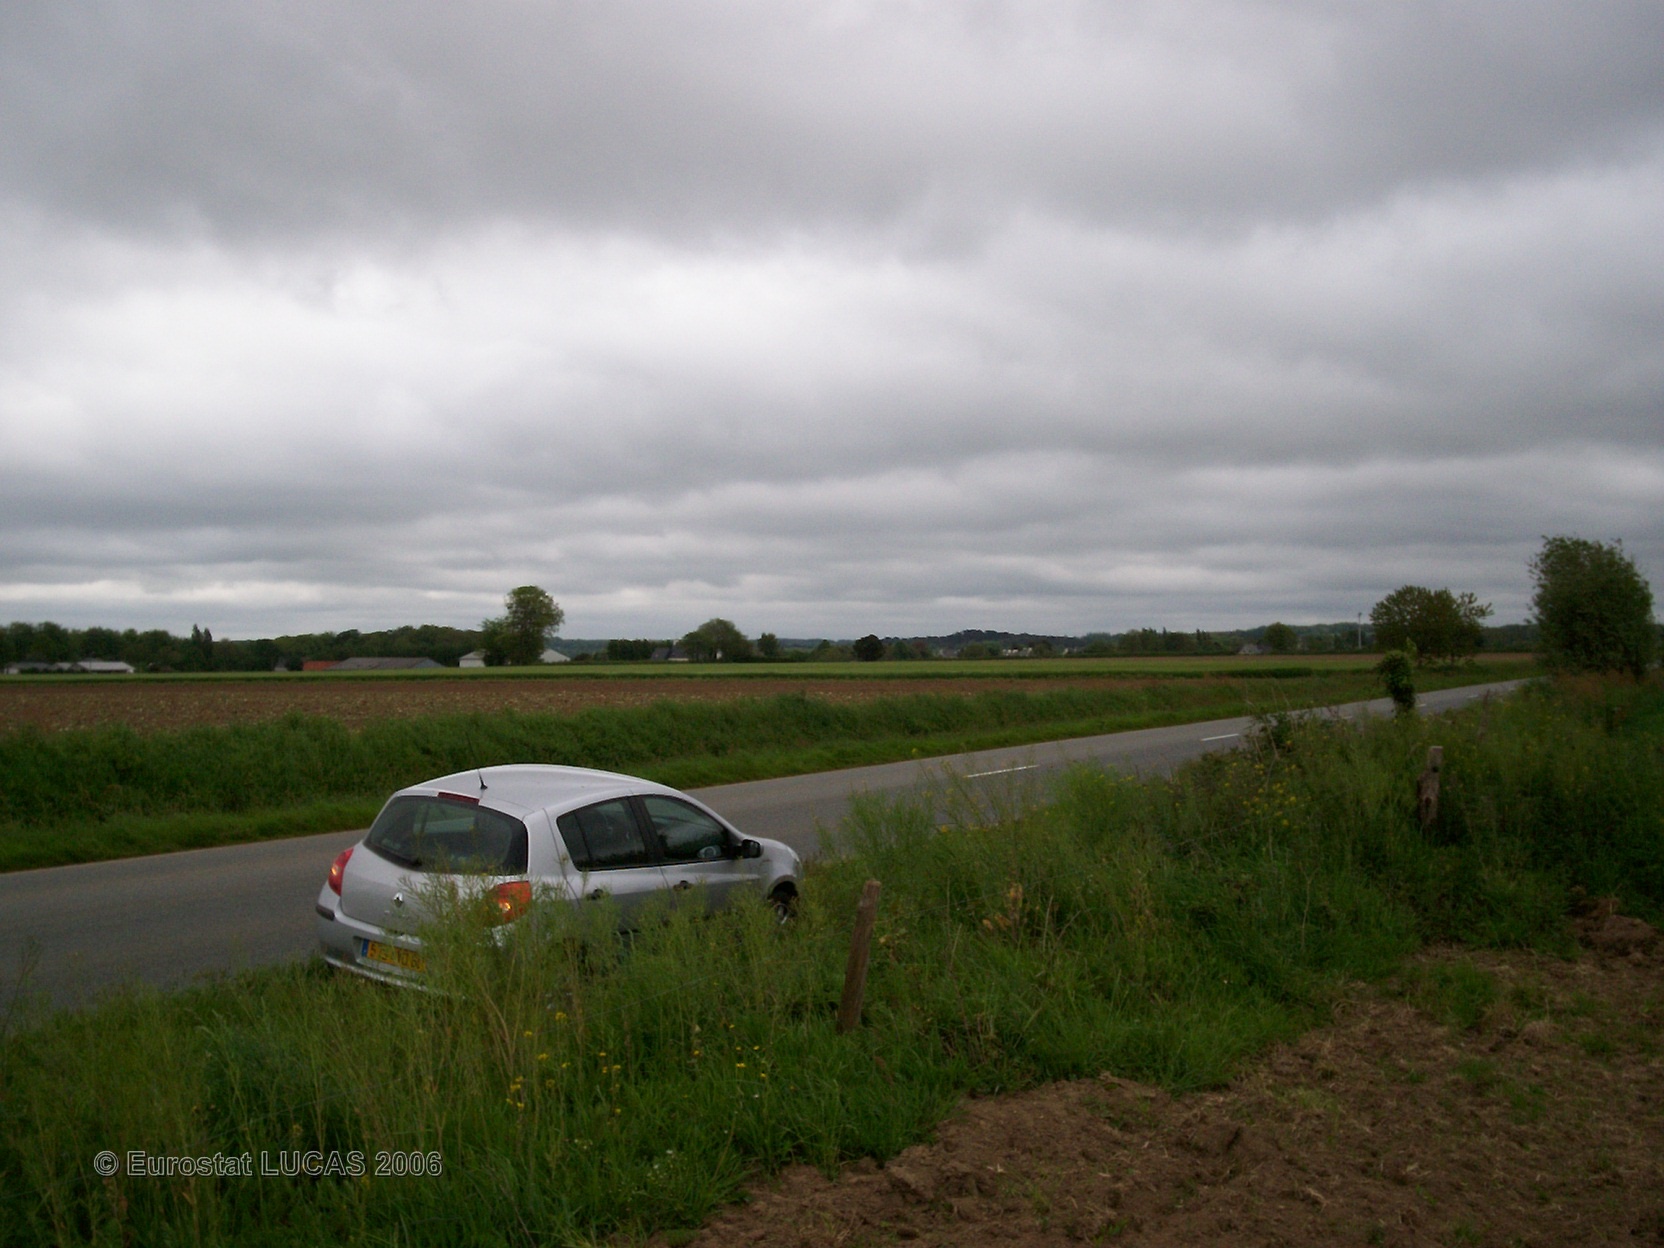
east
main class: Cropland
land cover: Maize
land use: Agriculture (excluding fallow land and kitchen gardens)
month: May
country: FR
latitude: 48.6235
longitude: -3.6905
